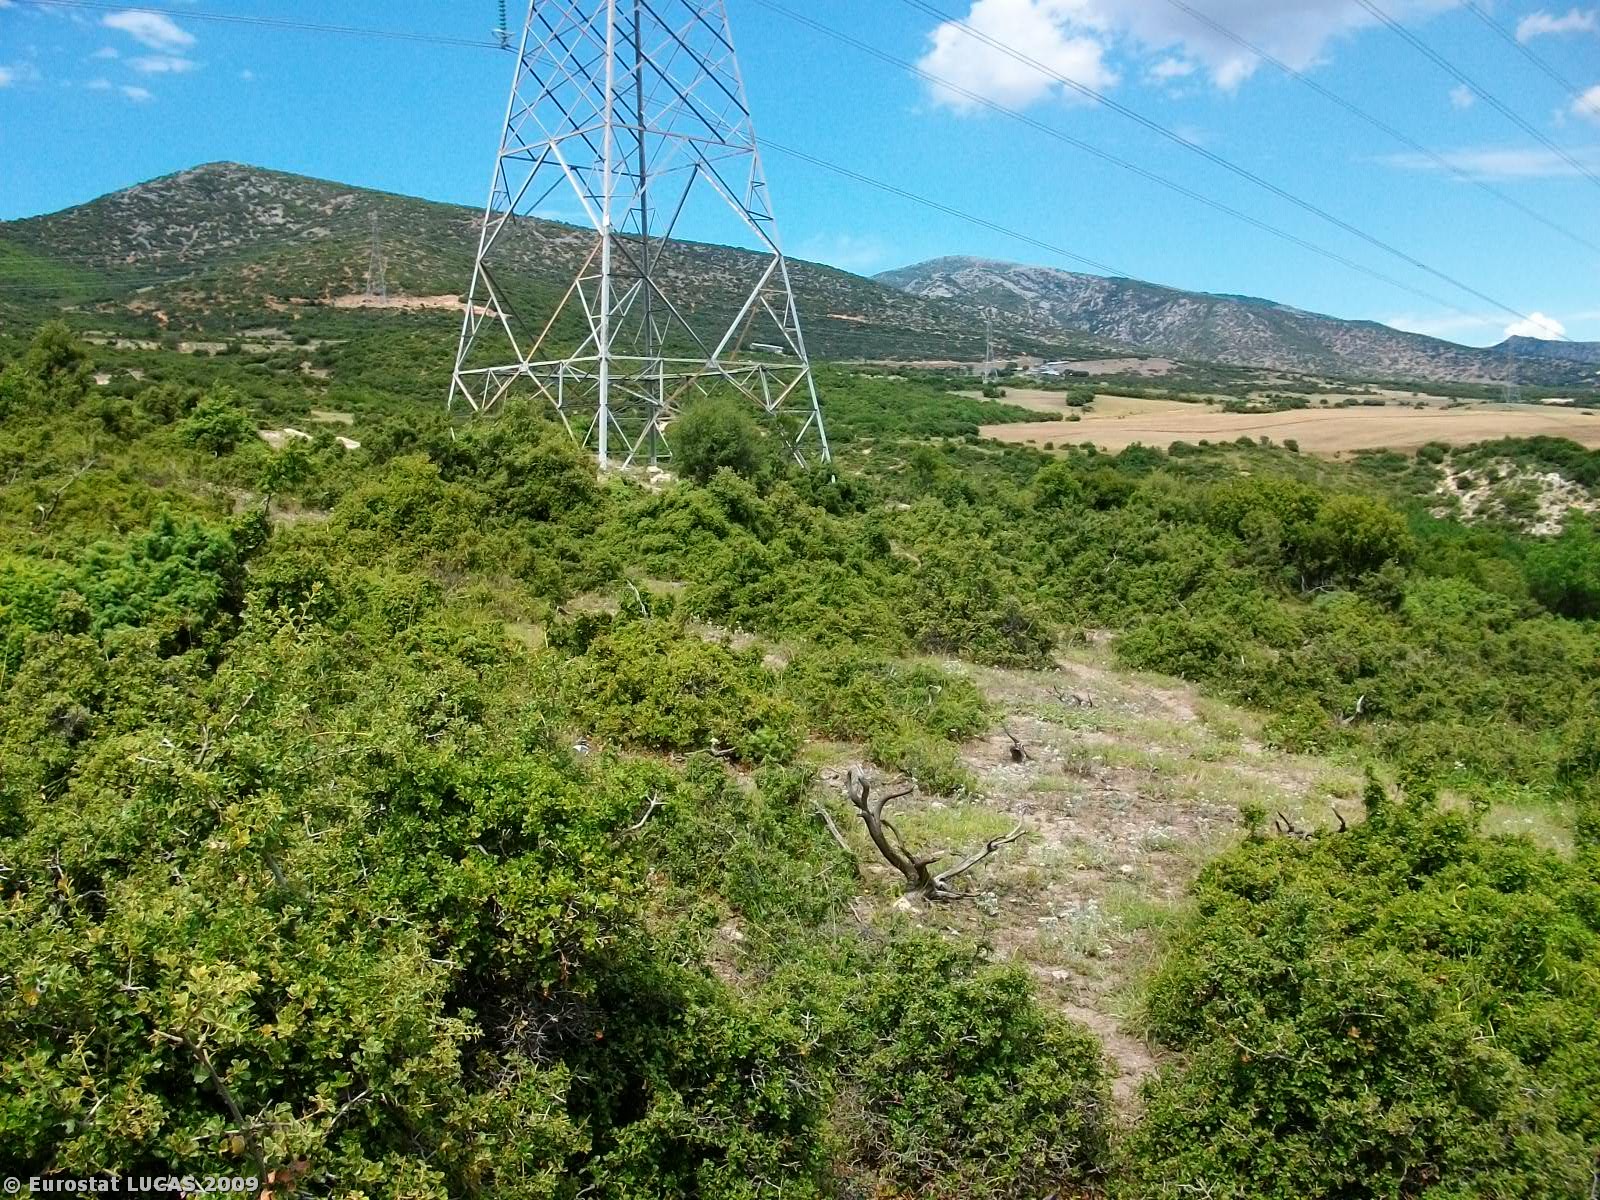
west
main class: Shrubland
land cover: Shrubland without tree cover
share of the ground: > 75 %
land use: Unused
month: July
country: GR
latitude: 40.1360
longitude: 21.8090
